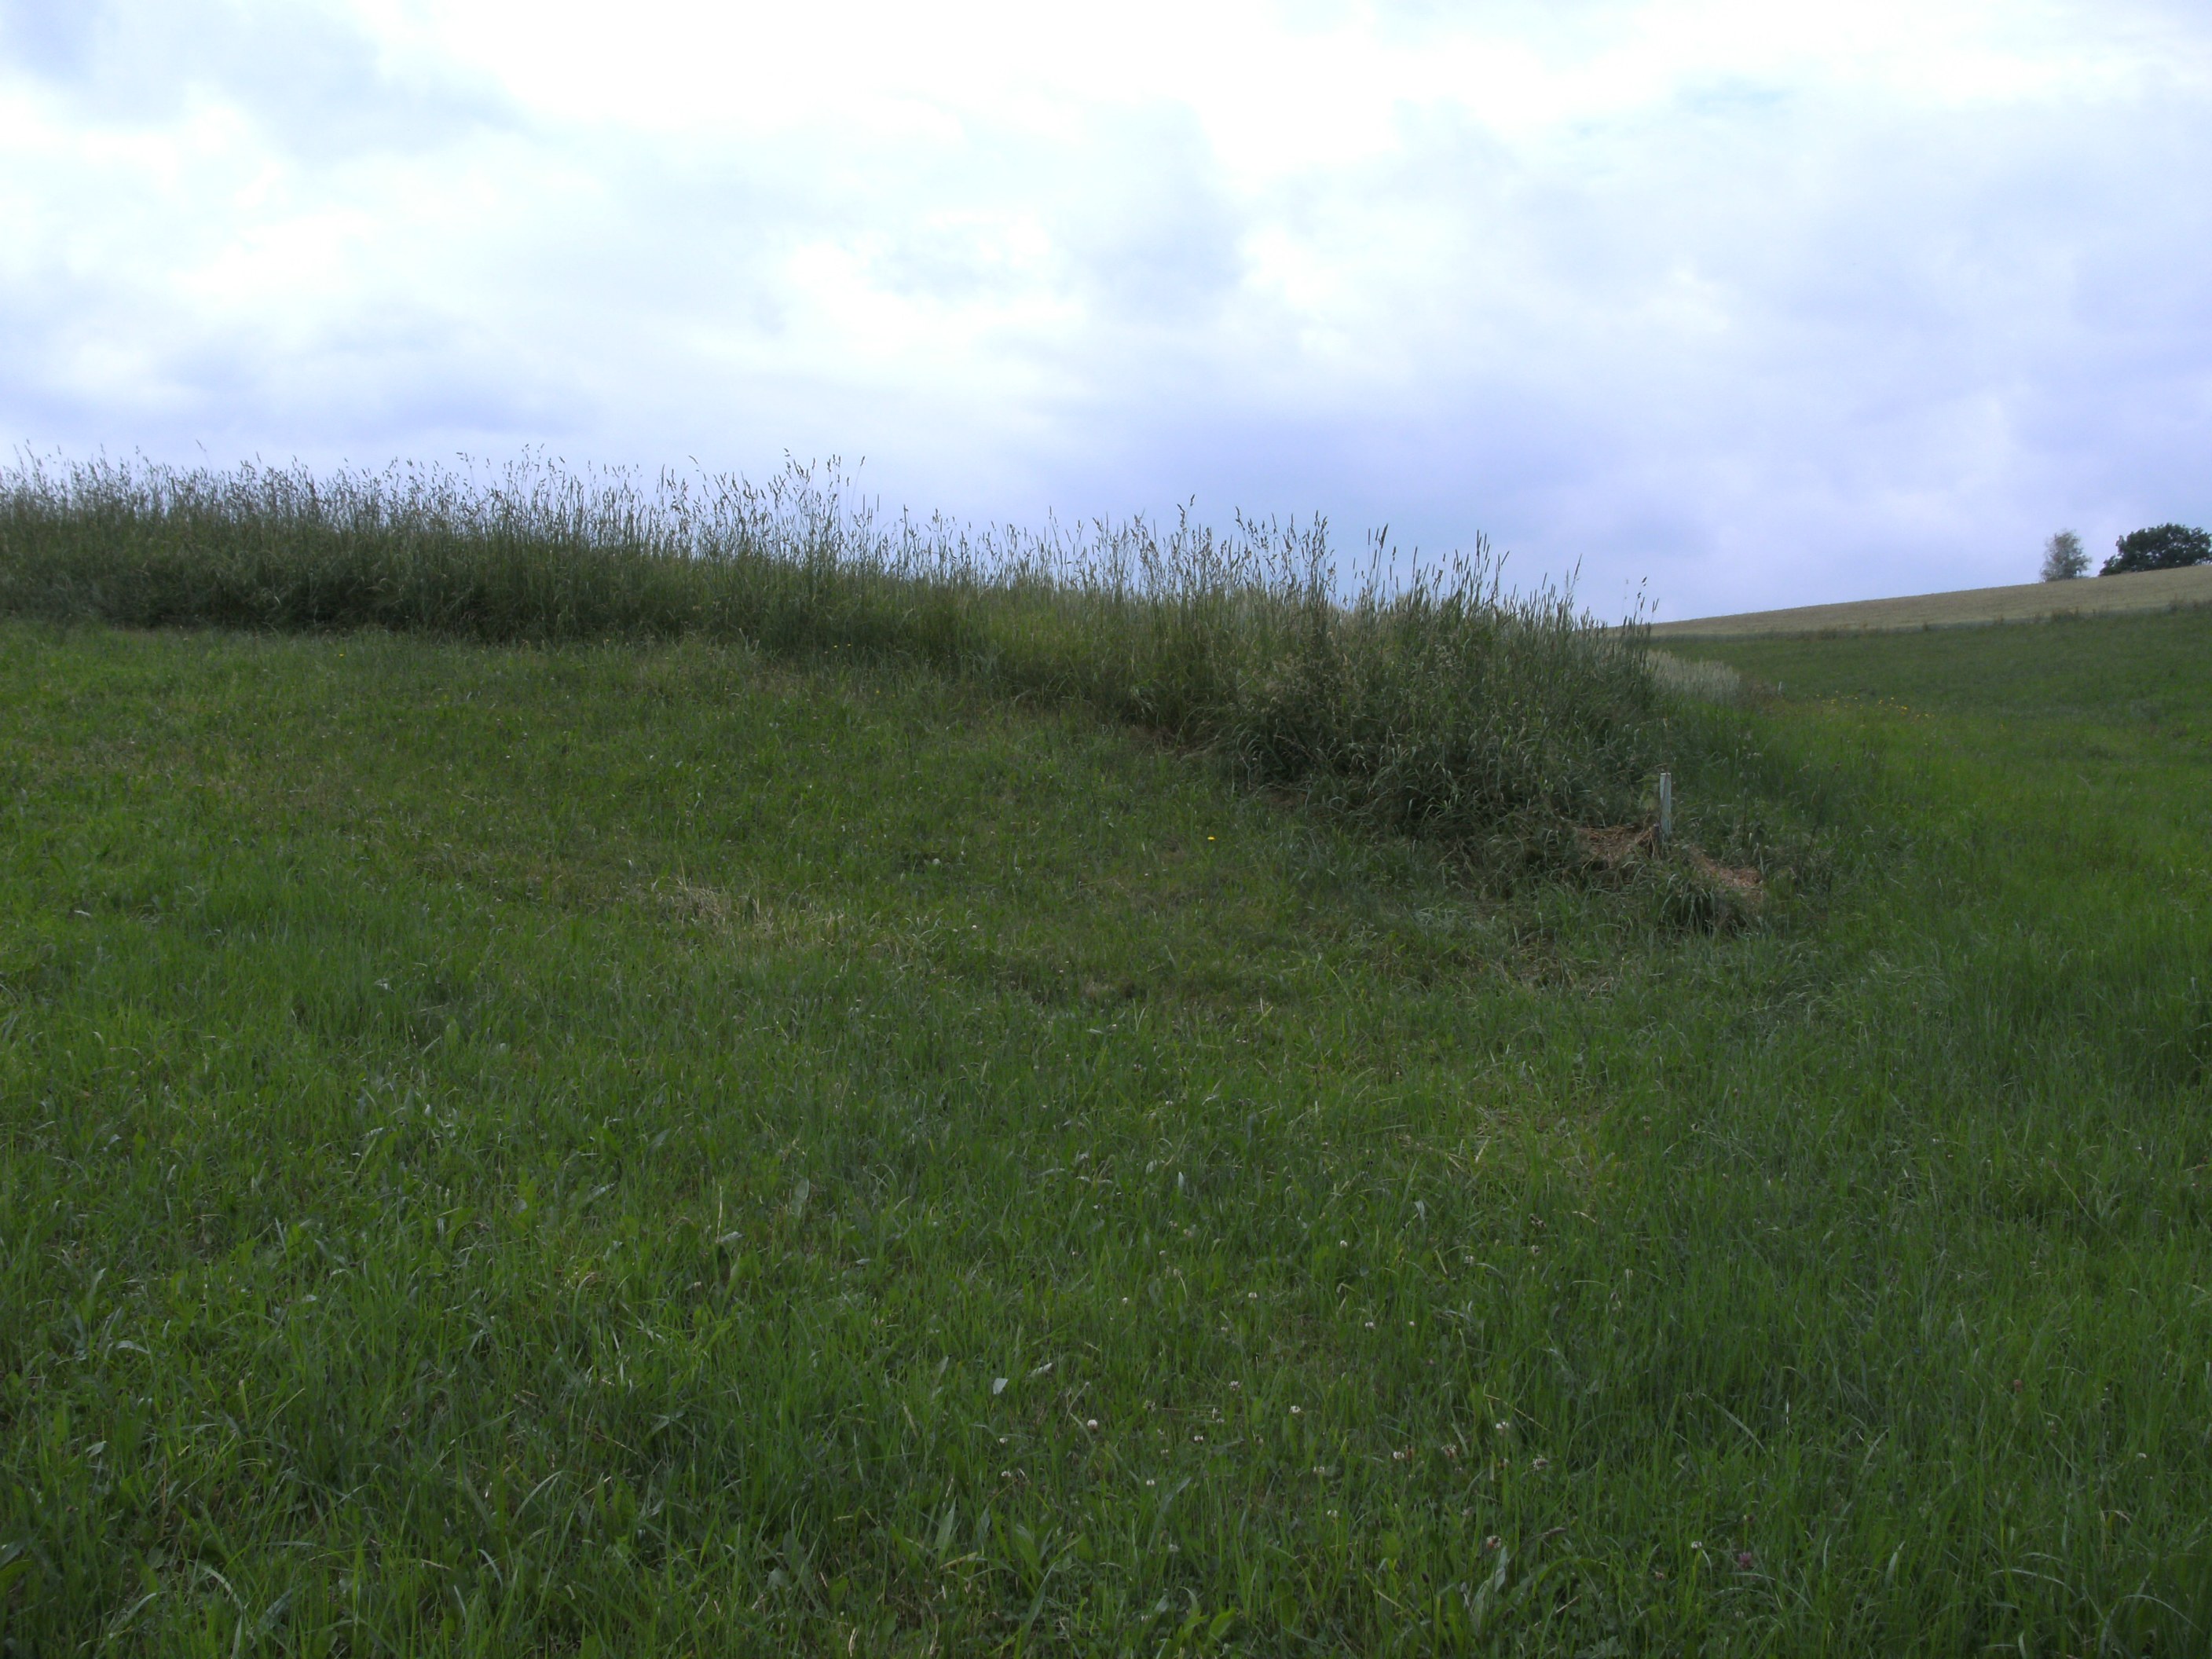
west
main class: Grassland
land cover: Grassland without tree/shrub cover
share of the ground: > 75 %
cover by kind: herbaceous plants 100 %
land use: Agriculture (excluding fallow land and kitchen gardens)
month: June
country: AT
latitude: 48.5096
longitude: 14.0474
